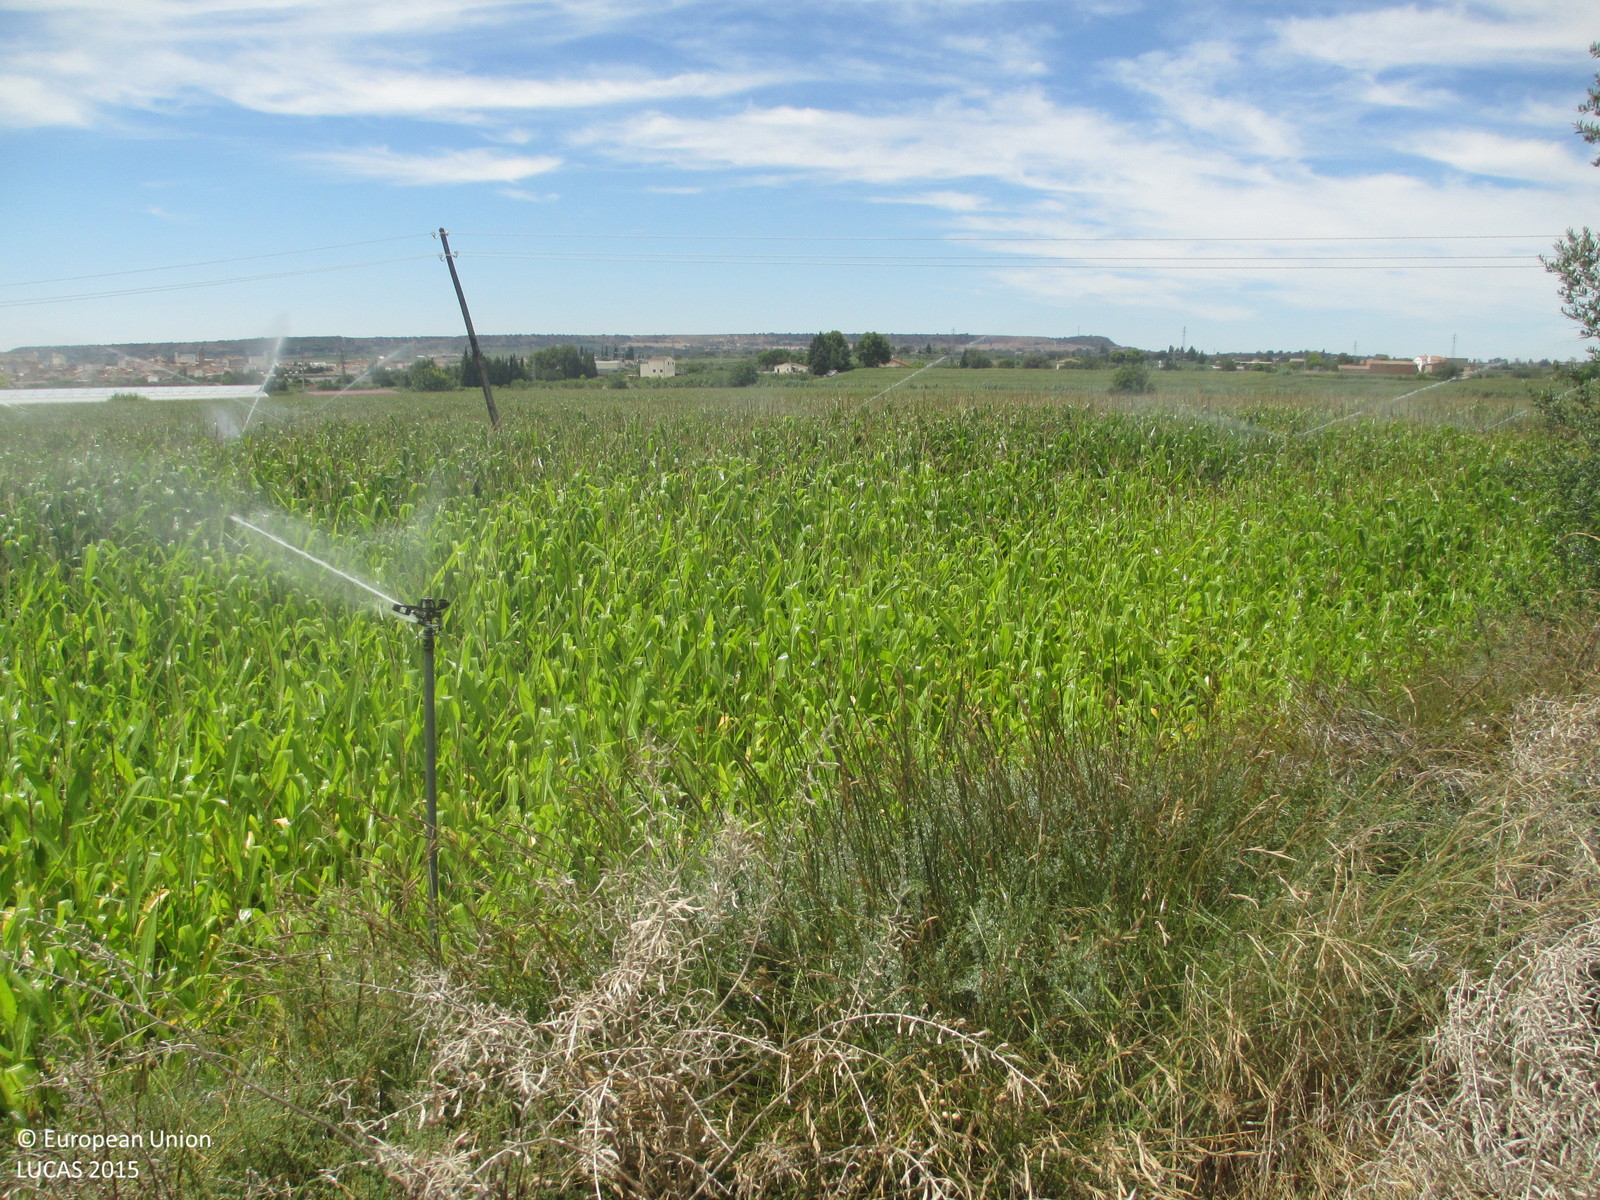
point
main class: Cropland
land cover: Maize
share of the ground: > 75 %
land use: Agriculture (excluding fallow land and kitchen gardens)
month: July
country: ES
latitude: 41.8612
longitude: 0.3107
